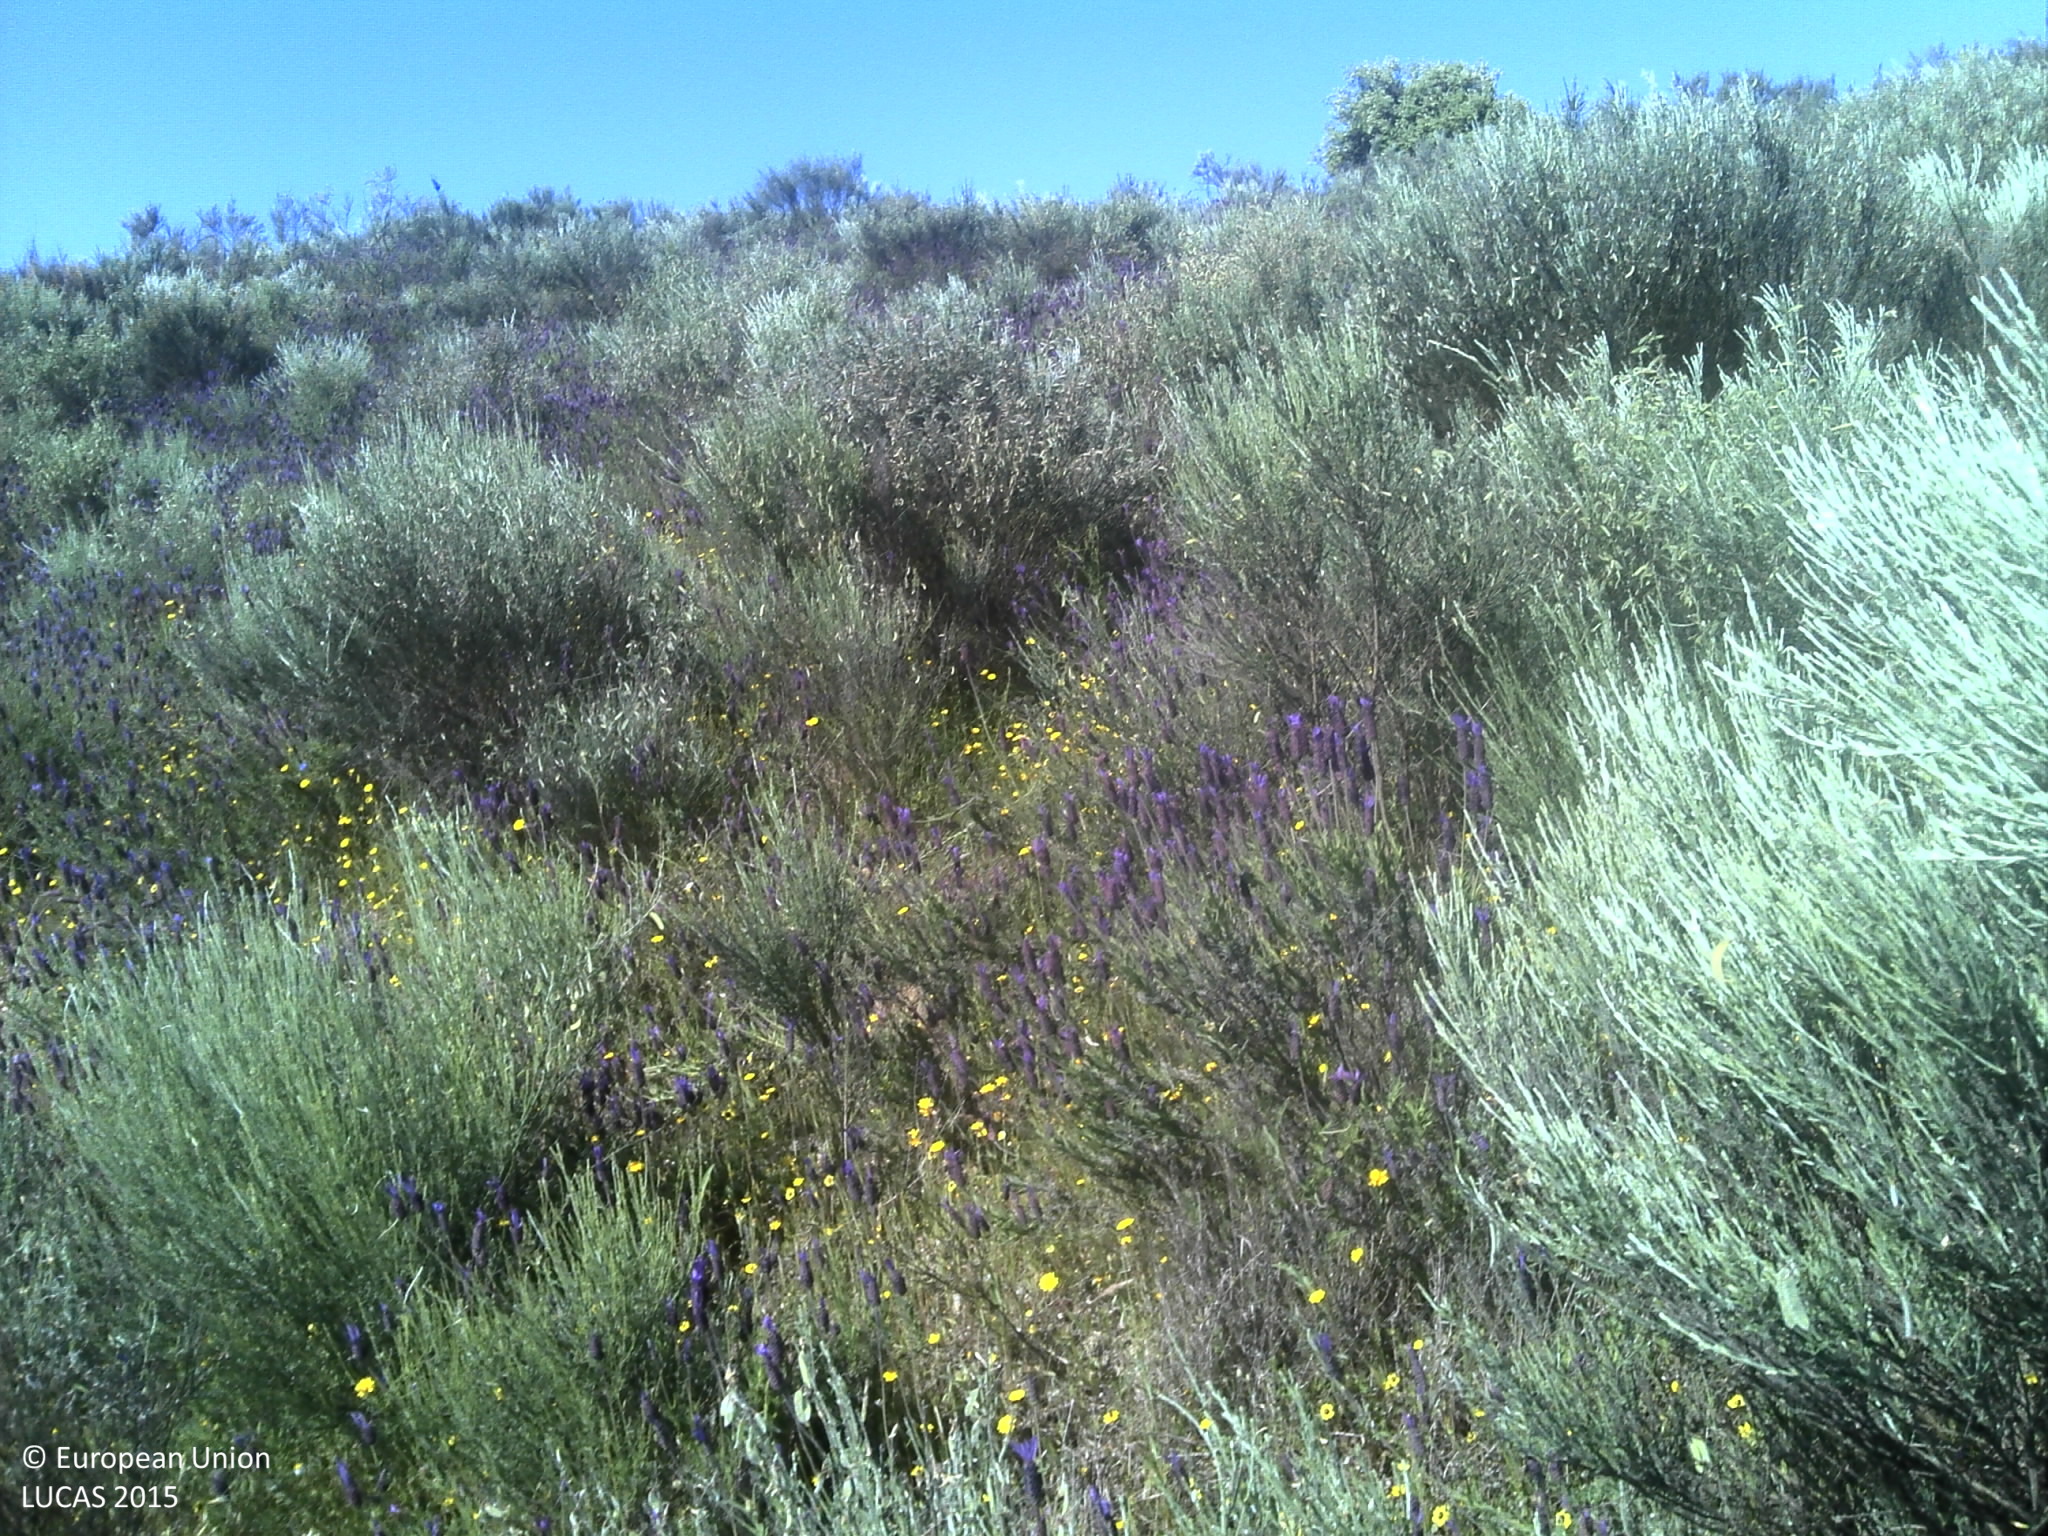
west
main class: Shrubland
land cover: Shrubland without tree cover
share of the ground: 50 - 75 %
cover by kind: shrubs 70 %, herbaceous plants 20 %, unconsolidated bare surface 10 %
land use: Abandoned areas
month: May
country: PT
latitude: 40.6947
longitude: -7.2799
